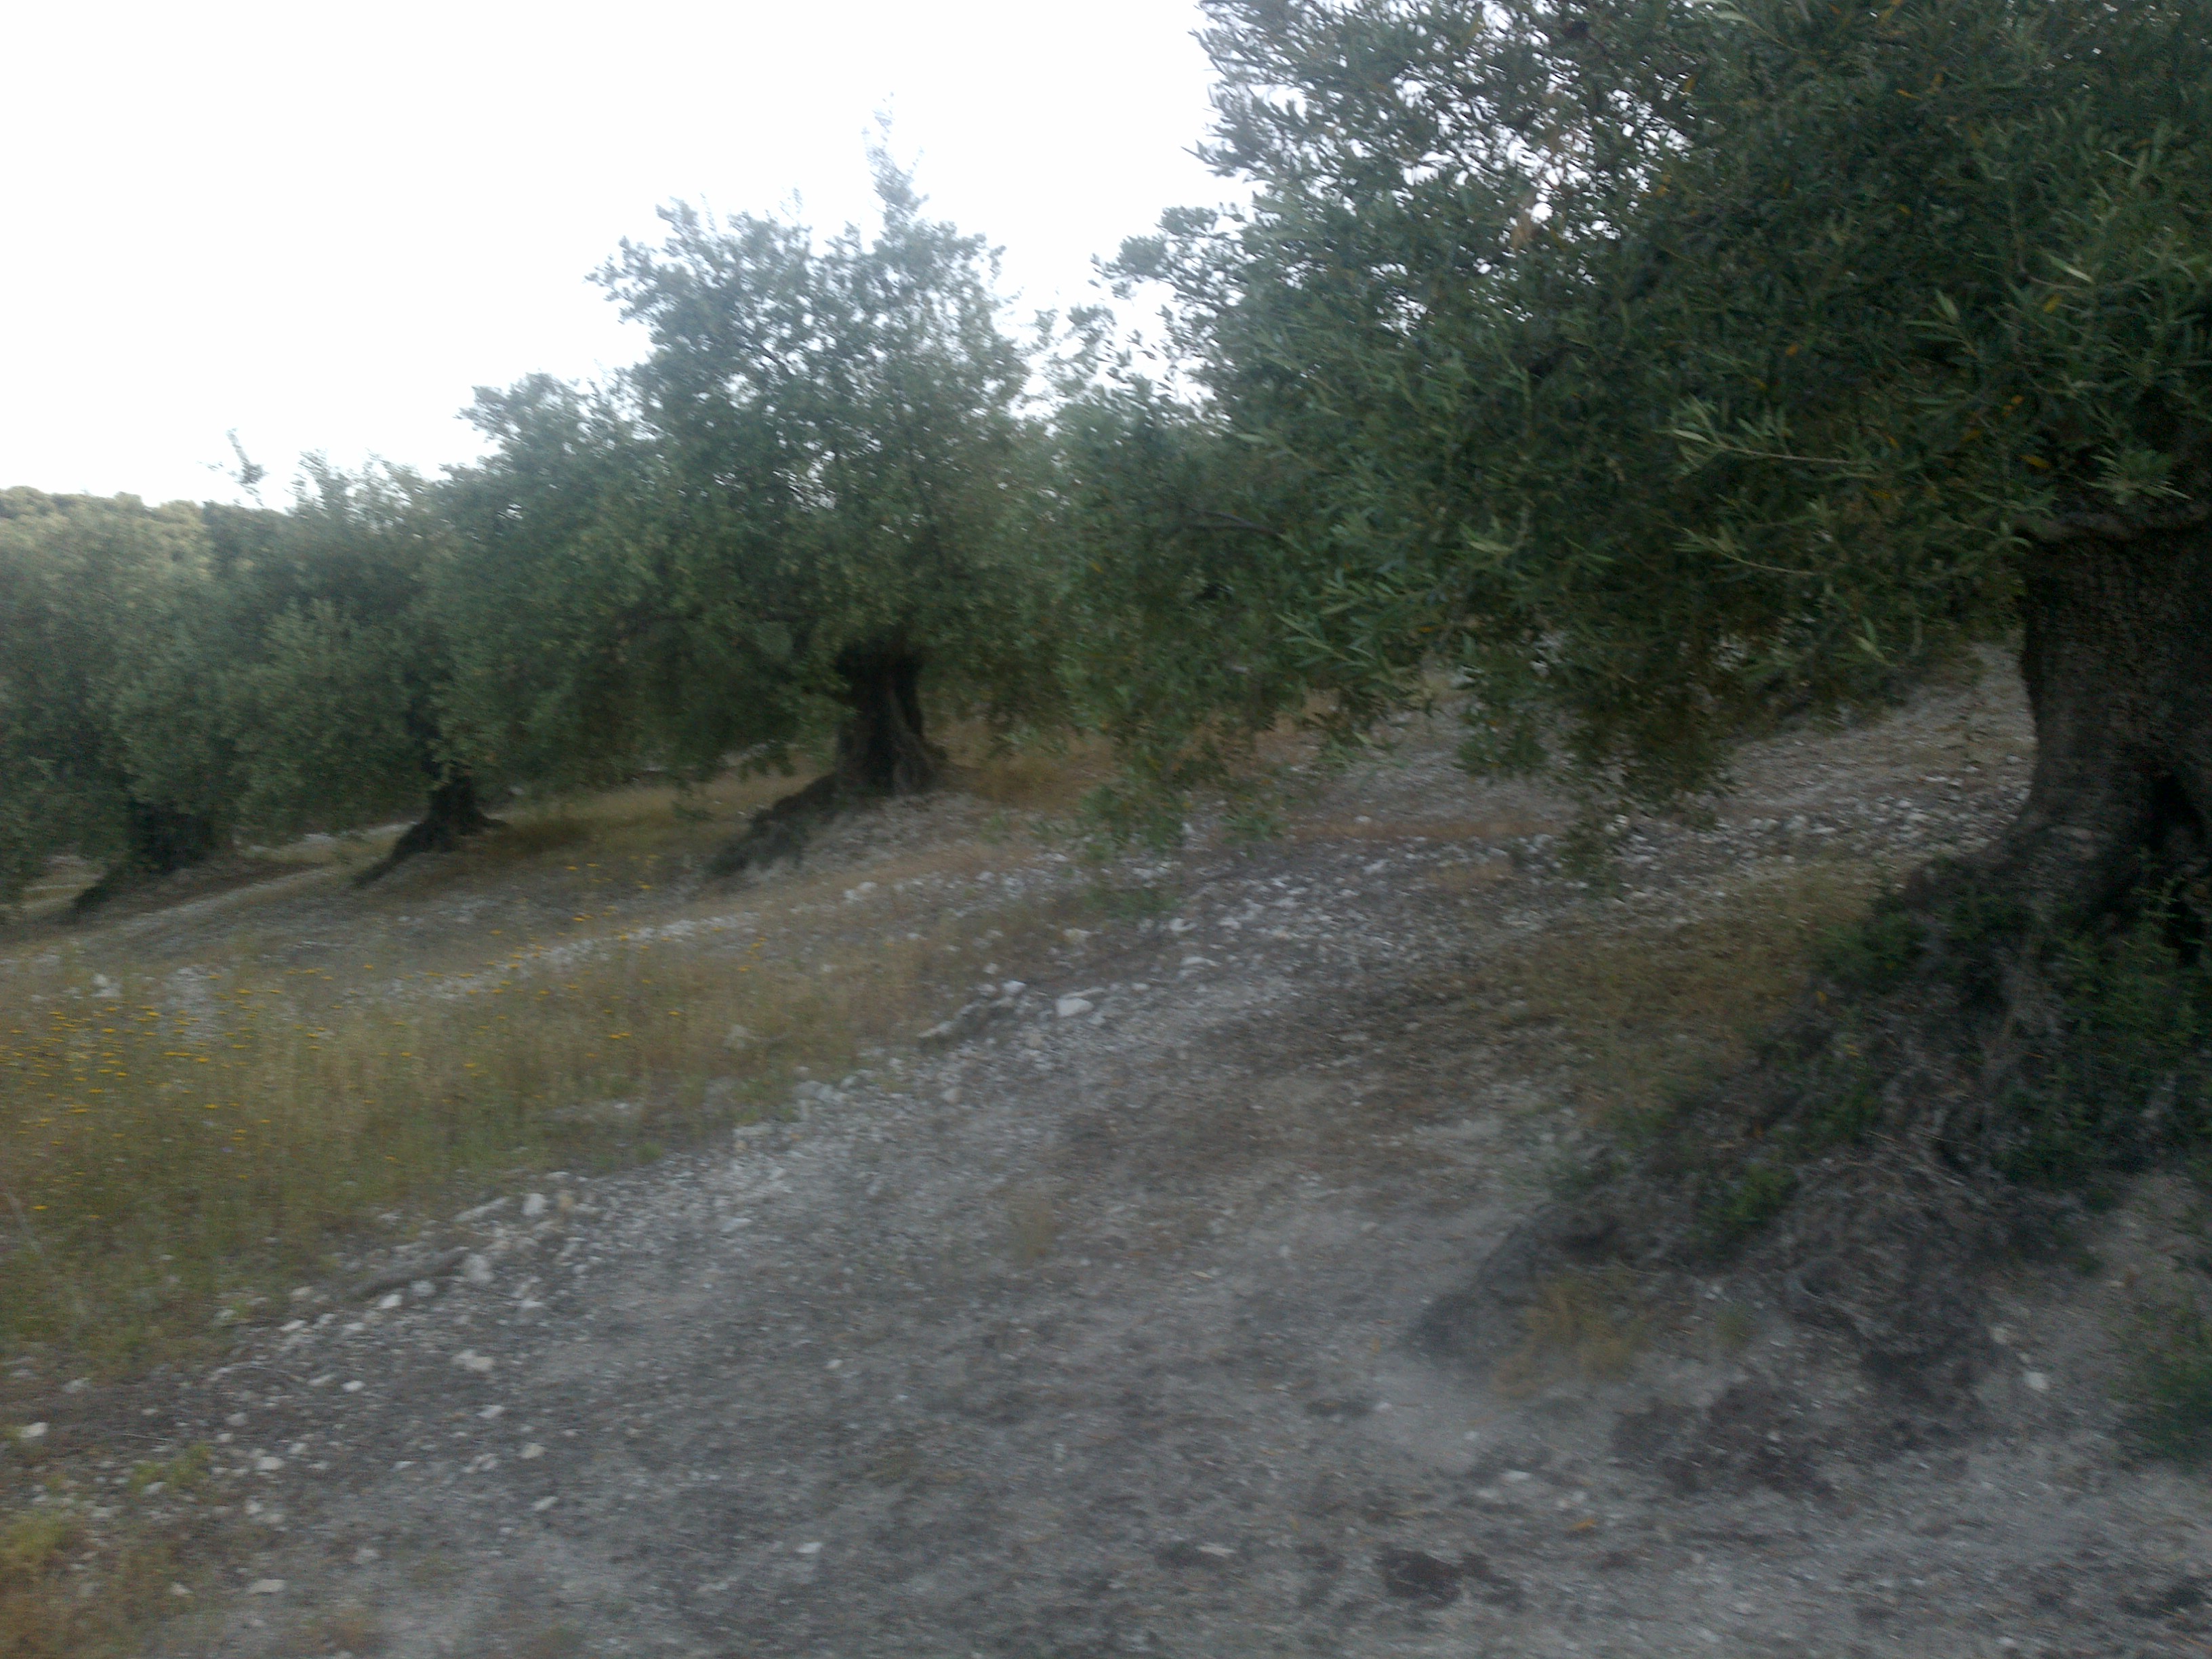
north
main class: Cropland
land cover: Olive groves
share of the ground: 50 - 75 %
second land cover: Spontaneously vegetated surfaces
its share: 10 - 25 %
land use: Agriculture (excluding fallow land and kitchen gardens)
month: May
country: ES
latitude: 37.4433
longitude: -4.2306
